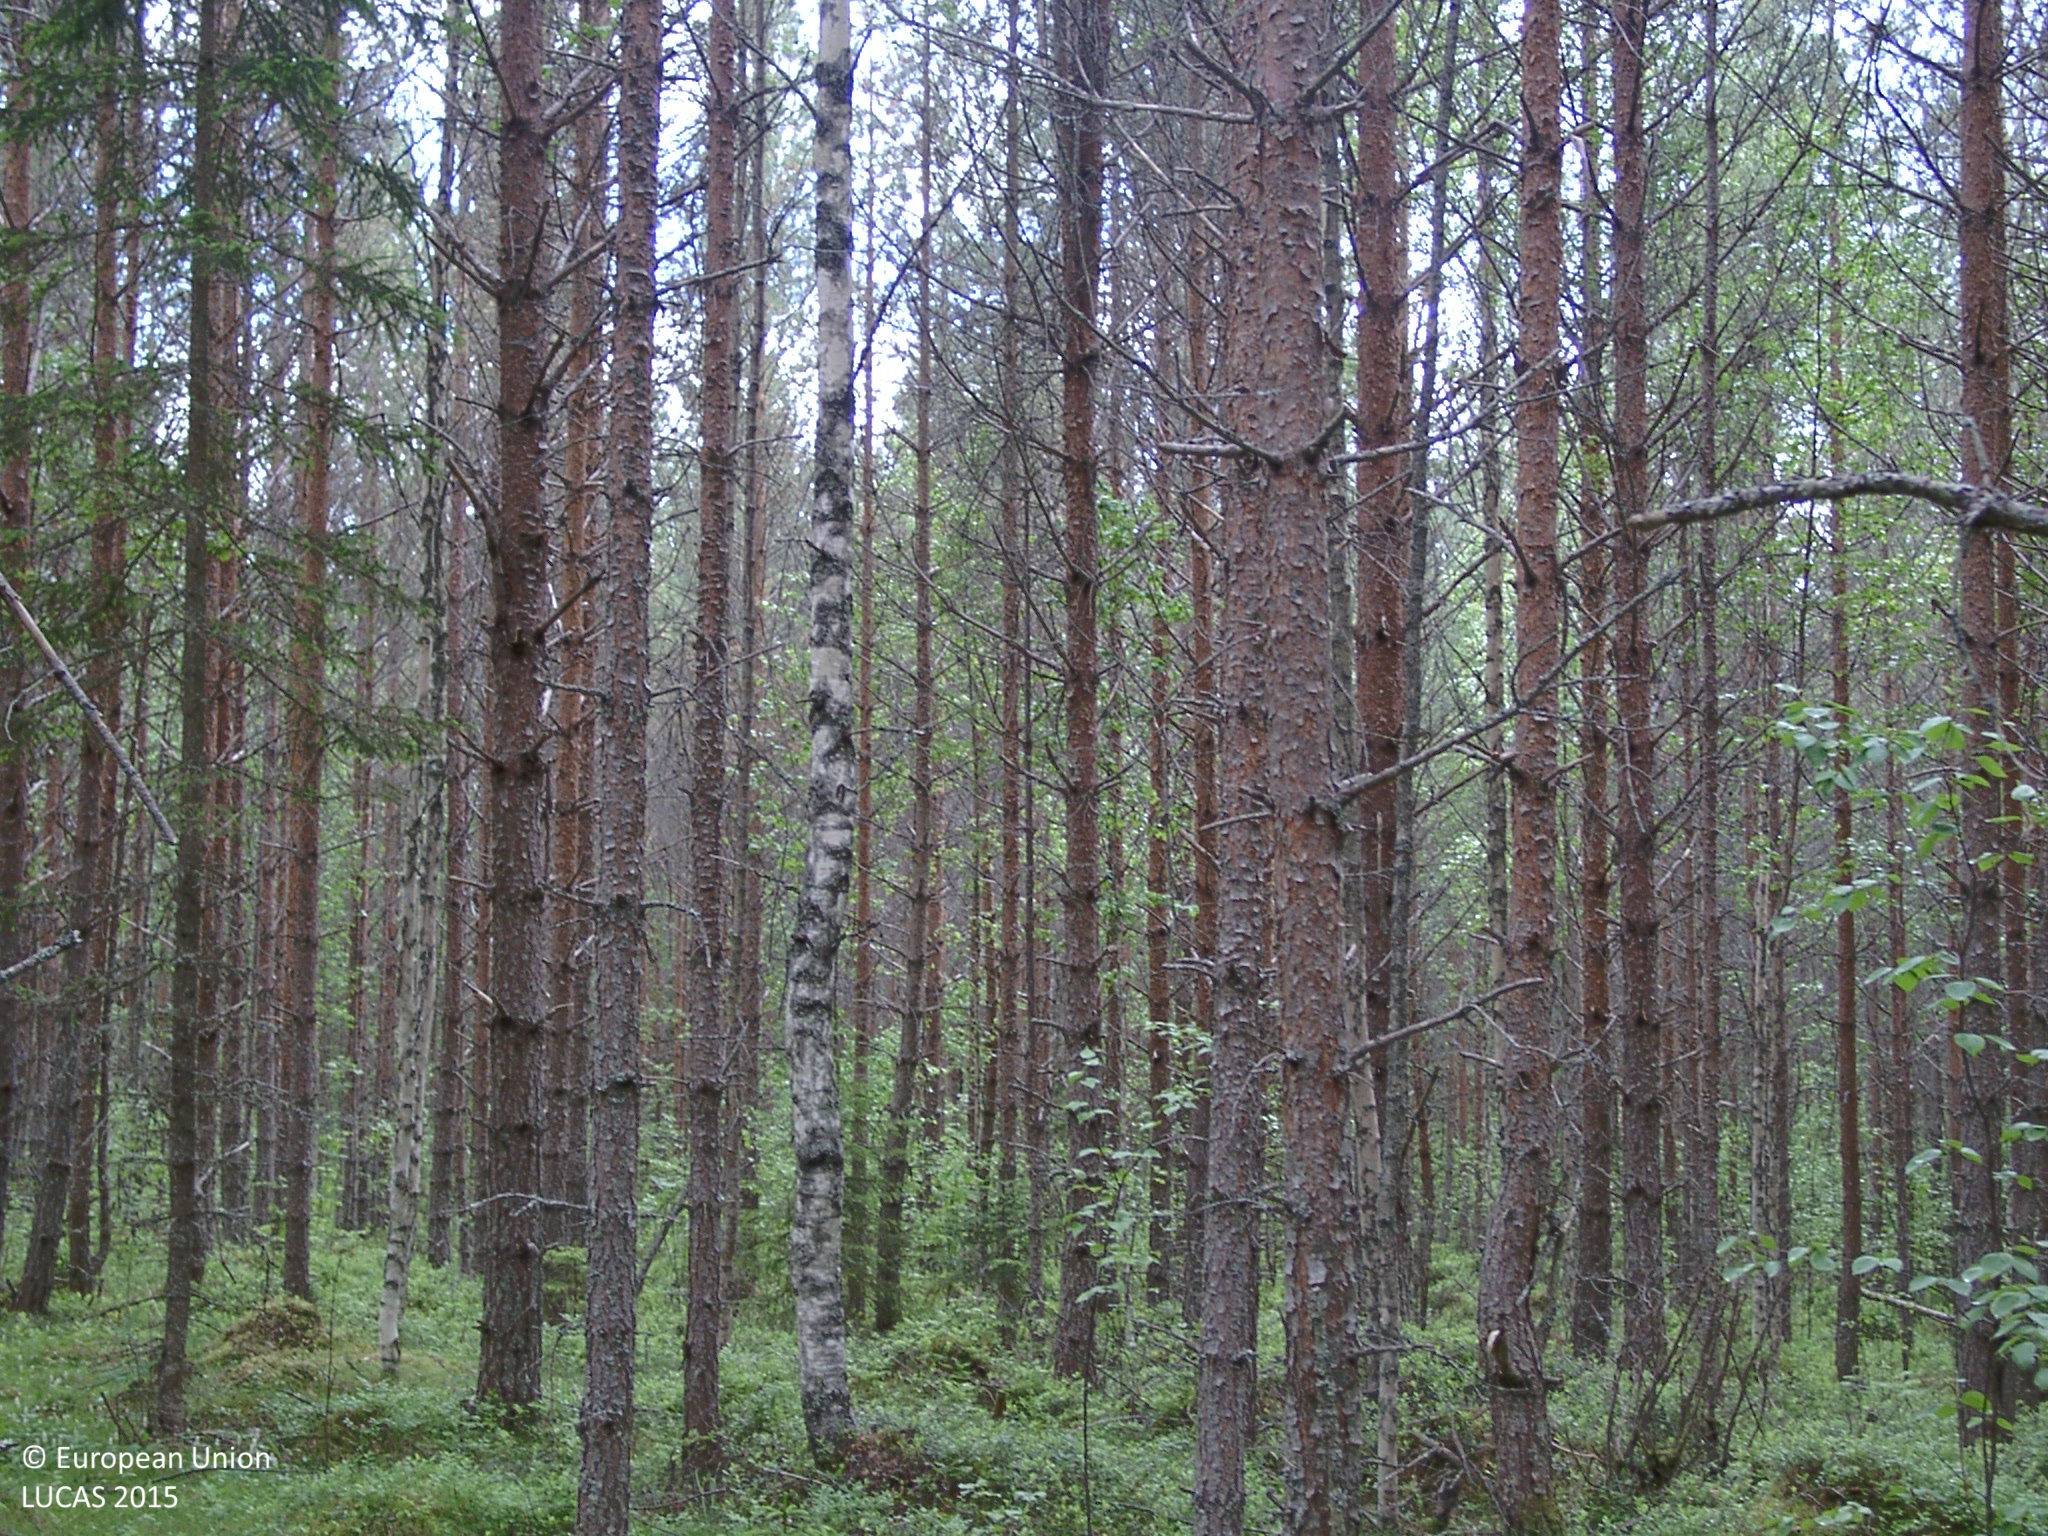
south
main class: Woodland
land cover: Pine dominated coniferous woodland
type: boreal forest
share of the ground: 50 - 75 %
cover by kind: coniferous forest trees 55 %, shrubs 15 %, herbaceous plants 15 %, broadleaved forest trees 10 %, lichens and mosses 5 %
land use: Forestry
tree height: > 5 m
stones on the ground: < 10 %
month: June
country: FI
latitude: 62.1282
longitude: 24.8455
